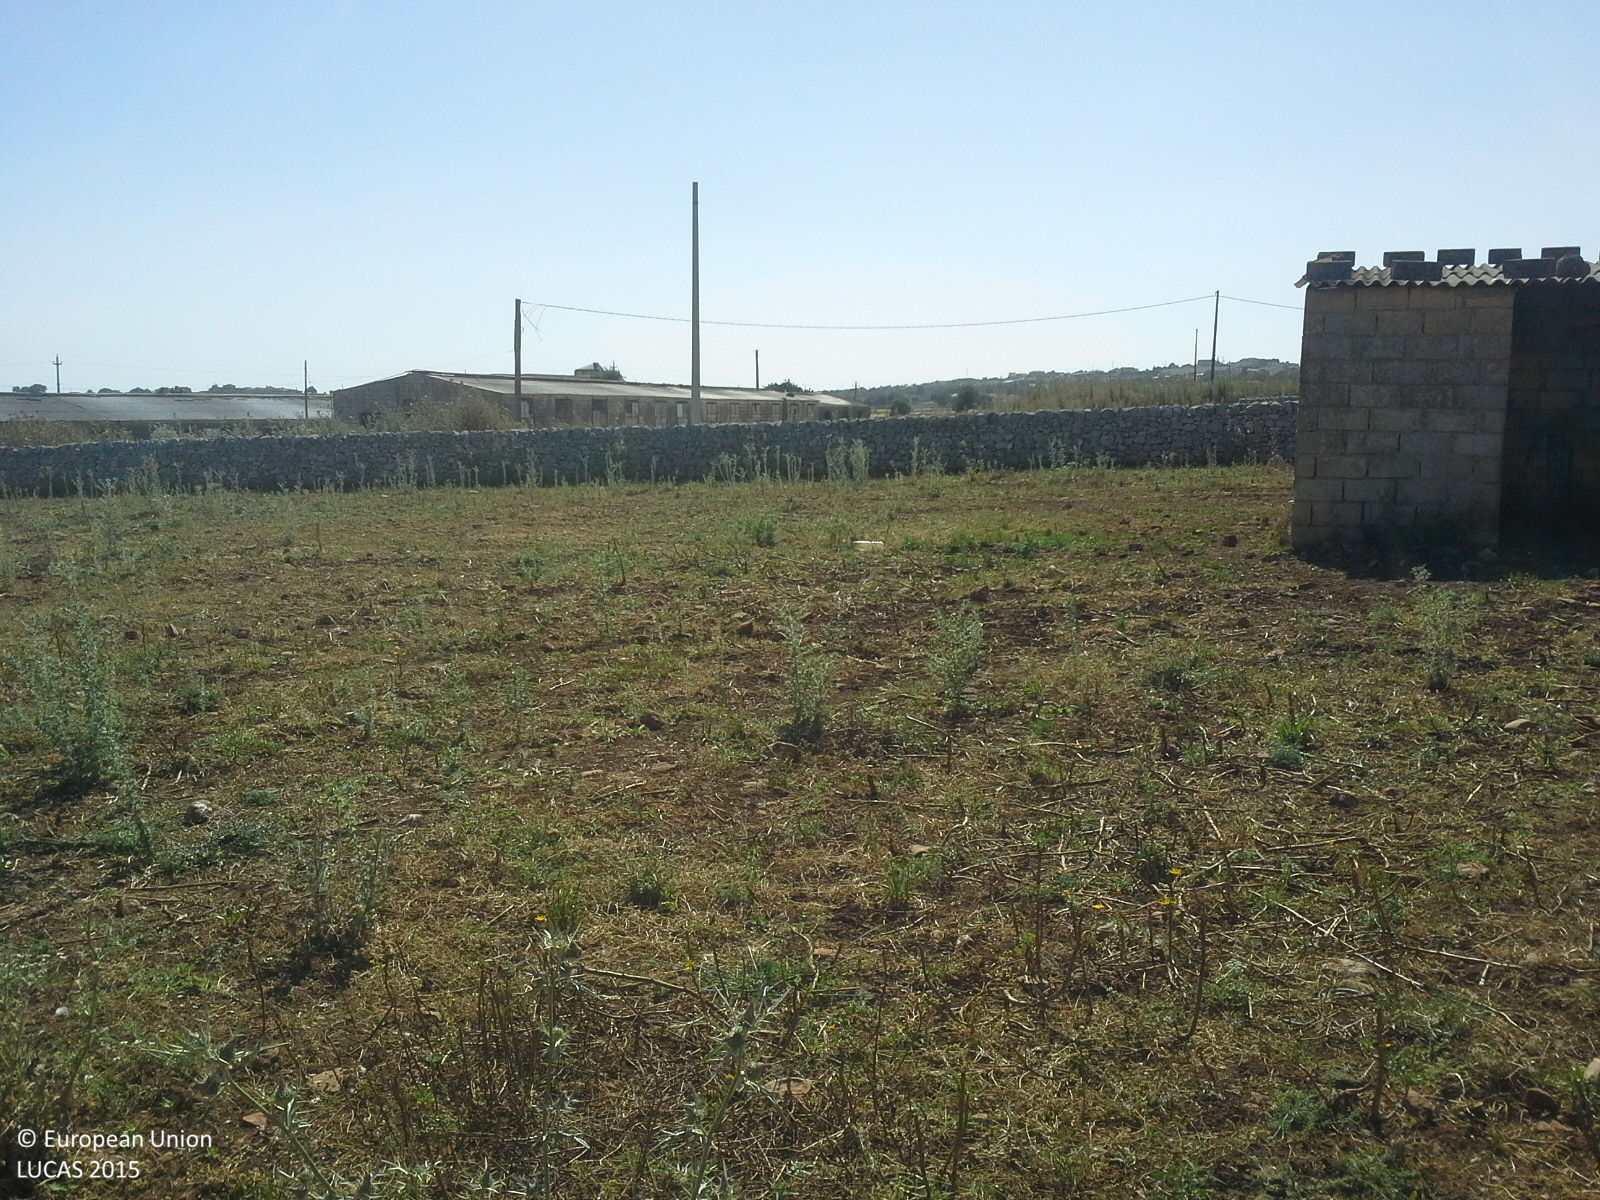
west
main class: Cropland
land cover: Mixed cereals for fodder
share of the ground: > 75 %
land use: Agriculture (excluding fallow land and kitchen gardens)
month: May
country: IT
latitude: 36.8058
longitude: 14.8368
